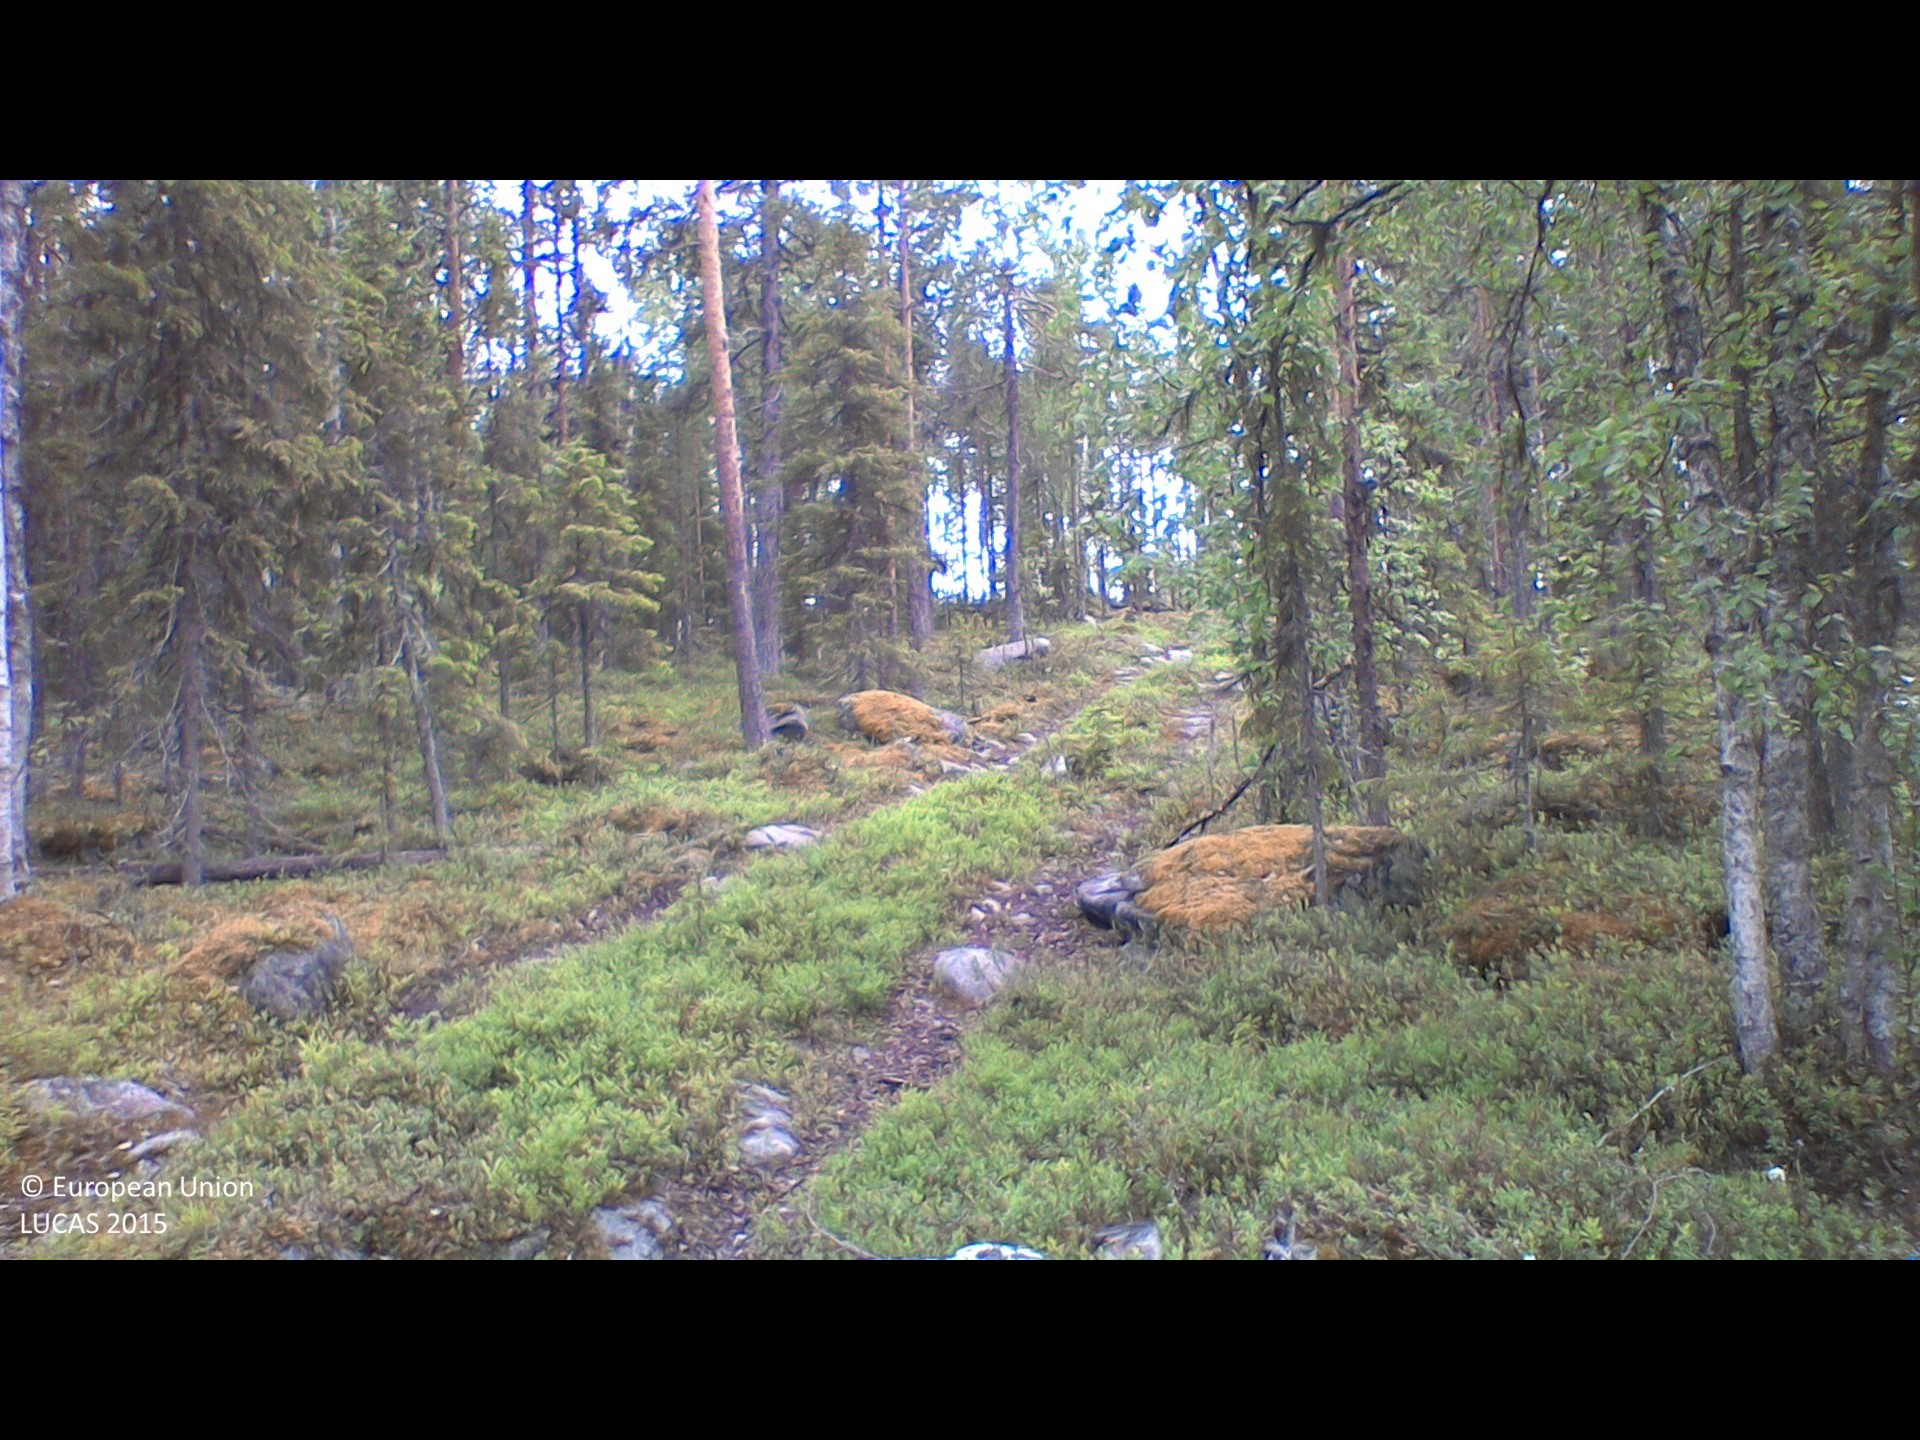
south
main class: Woodland
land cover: Pine dominated mixed woodland
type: boreal forest
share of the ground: 25 - 50 %
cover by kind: shrubs 70 %, coniferous forest trees 15 %, broadleaved forest trees 10 %, unconsolidated bare surface 5 %
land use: Forestry
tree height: > 5 m
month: July
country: SE
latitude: 66.7591
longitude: 23.0785
